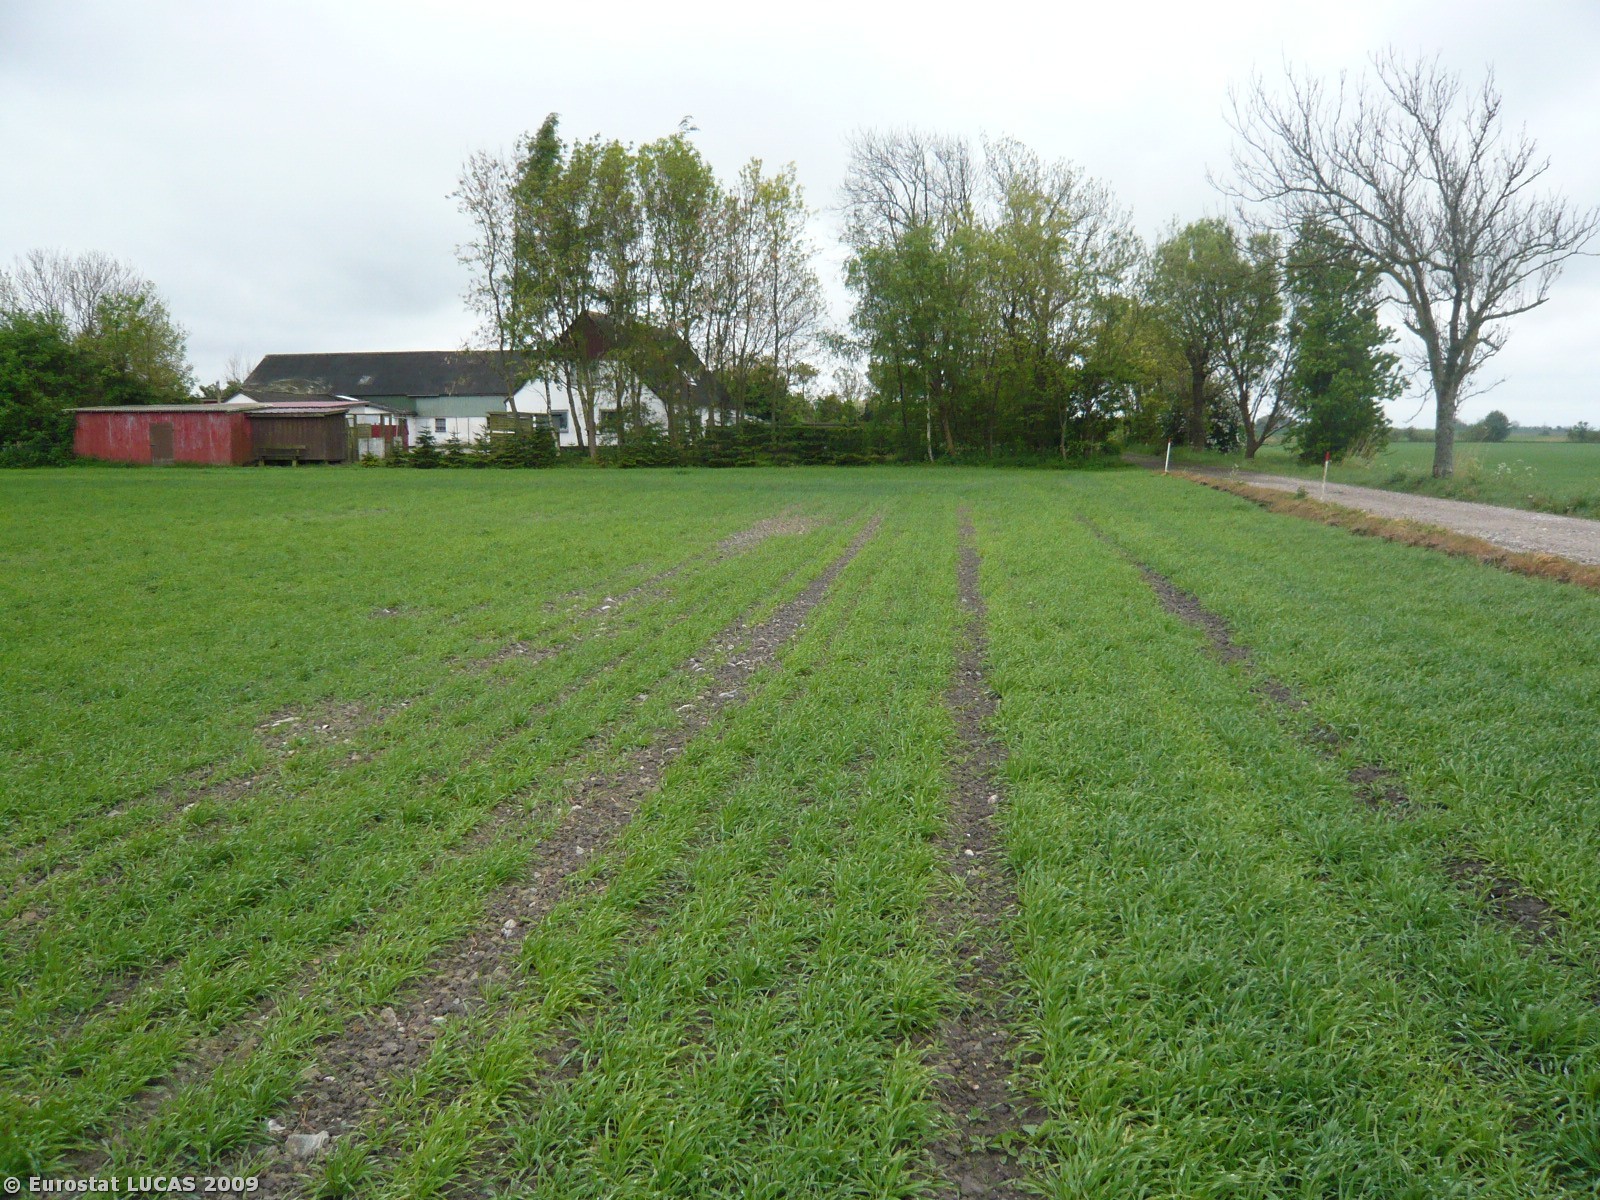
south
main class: Cropland
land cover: Barley
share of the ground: > 75 %
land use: Agriculture (excluding fallow land and kitchen gardens)
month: May
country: DK
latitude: 55.1148
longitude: 11.7703
